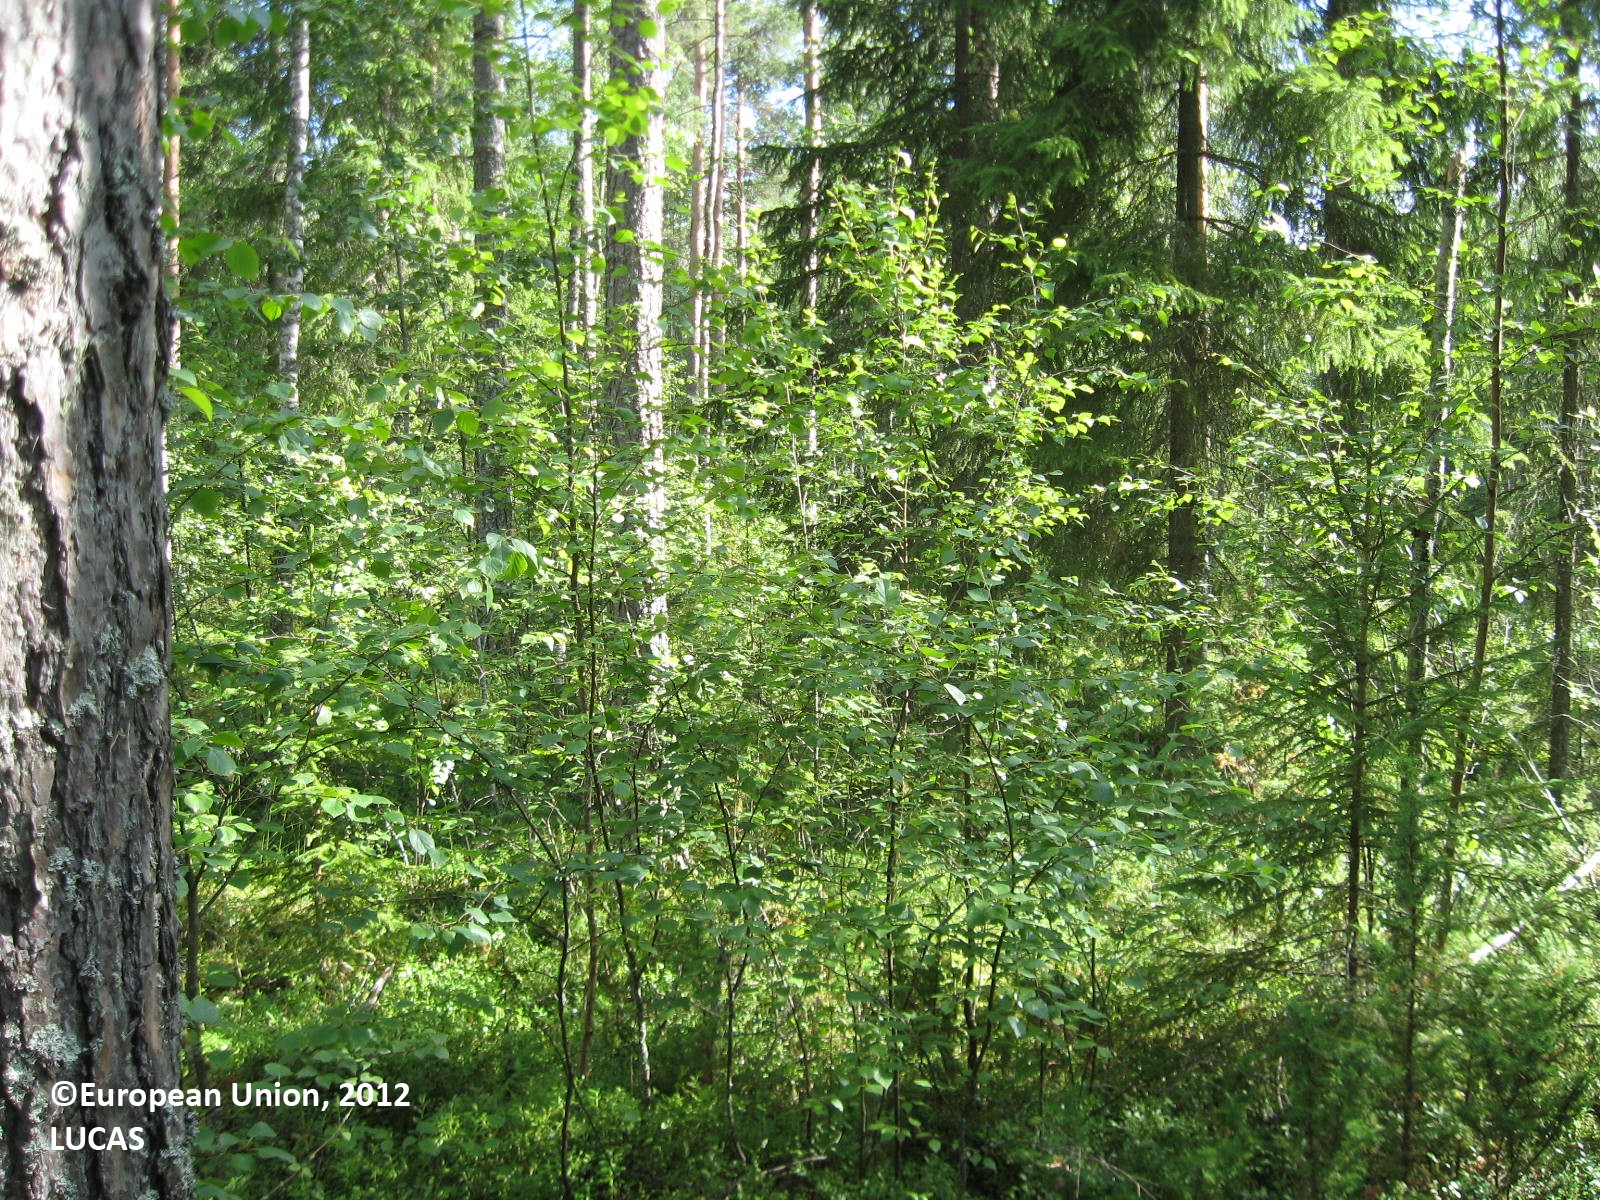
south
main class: Woodland
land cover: Pine dominated mixed woodland
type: boreal forest
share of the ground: > 75 %
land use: Forestry
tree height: > 5 m
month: July
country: FI
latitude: 62.0751
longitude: 21.5507
